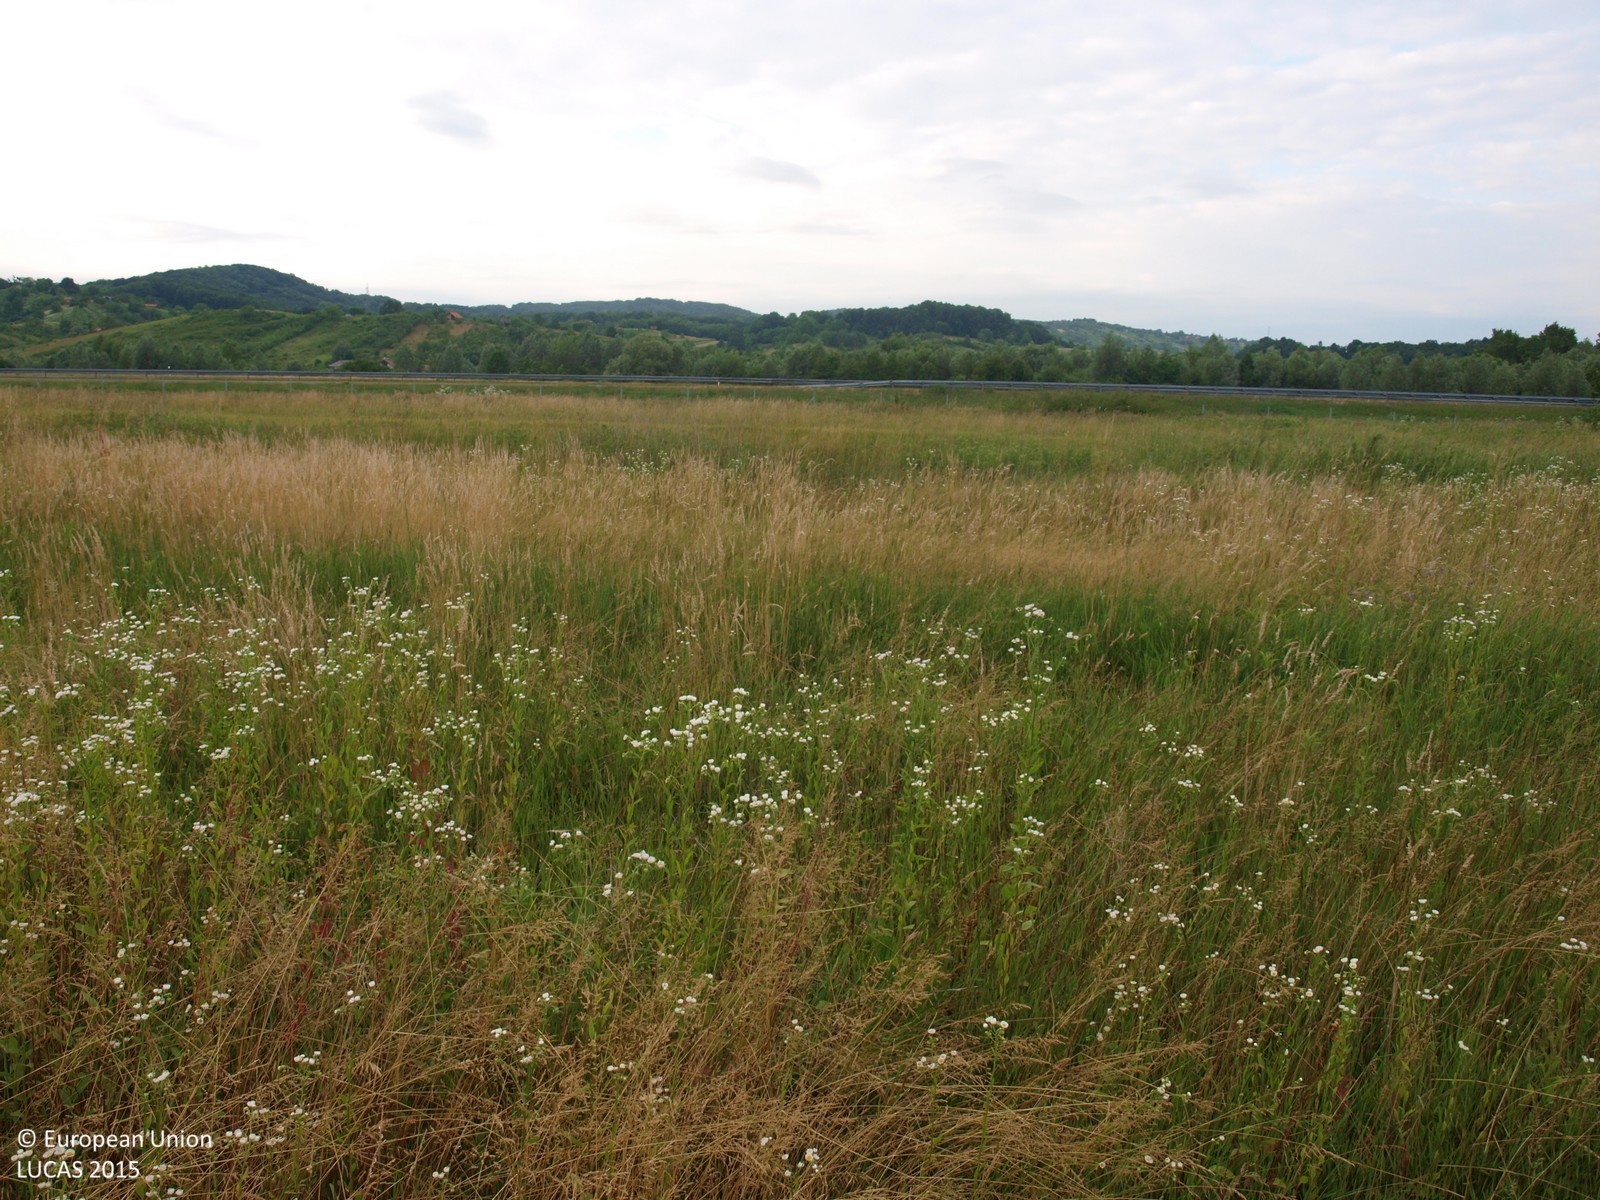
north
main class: Grassland
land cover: Grassland without tree/shrub cover
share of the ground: > 75 %
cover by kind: herbaceous plants 100 %
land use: Agriculture (excluding fallow land and kitchen gardens)
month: June
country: HR
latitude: 46.1784
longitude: 16.3863
